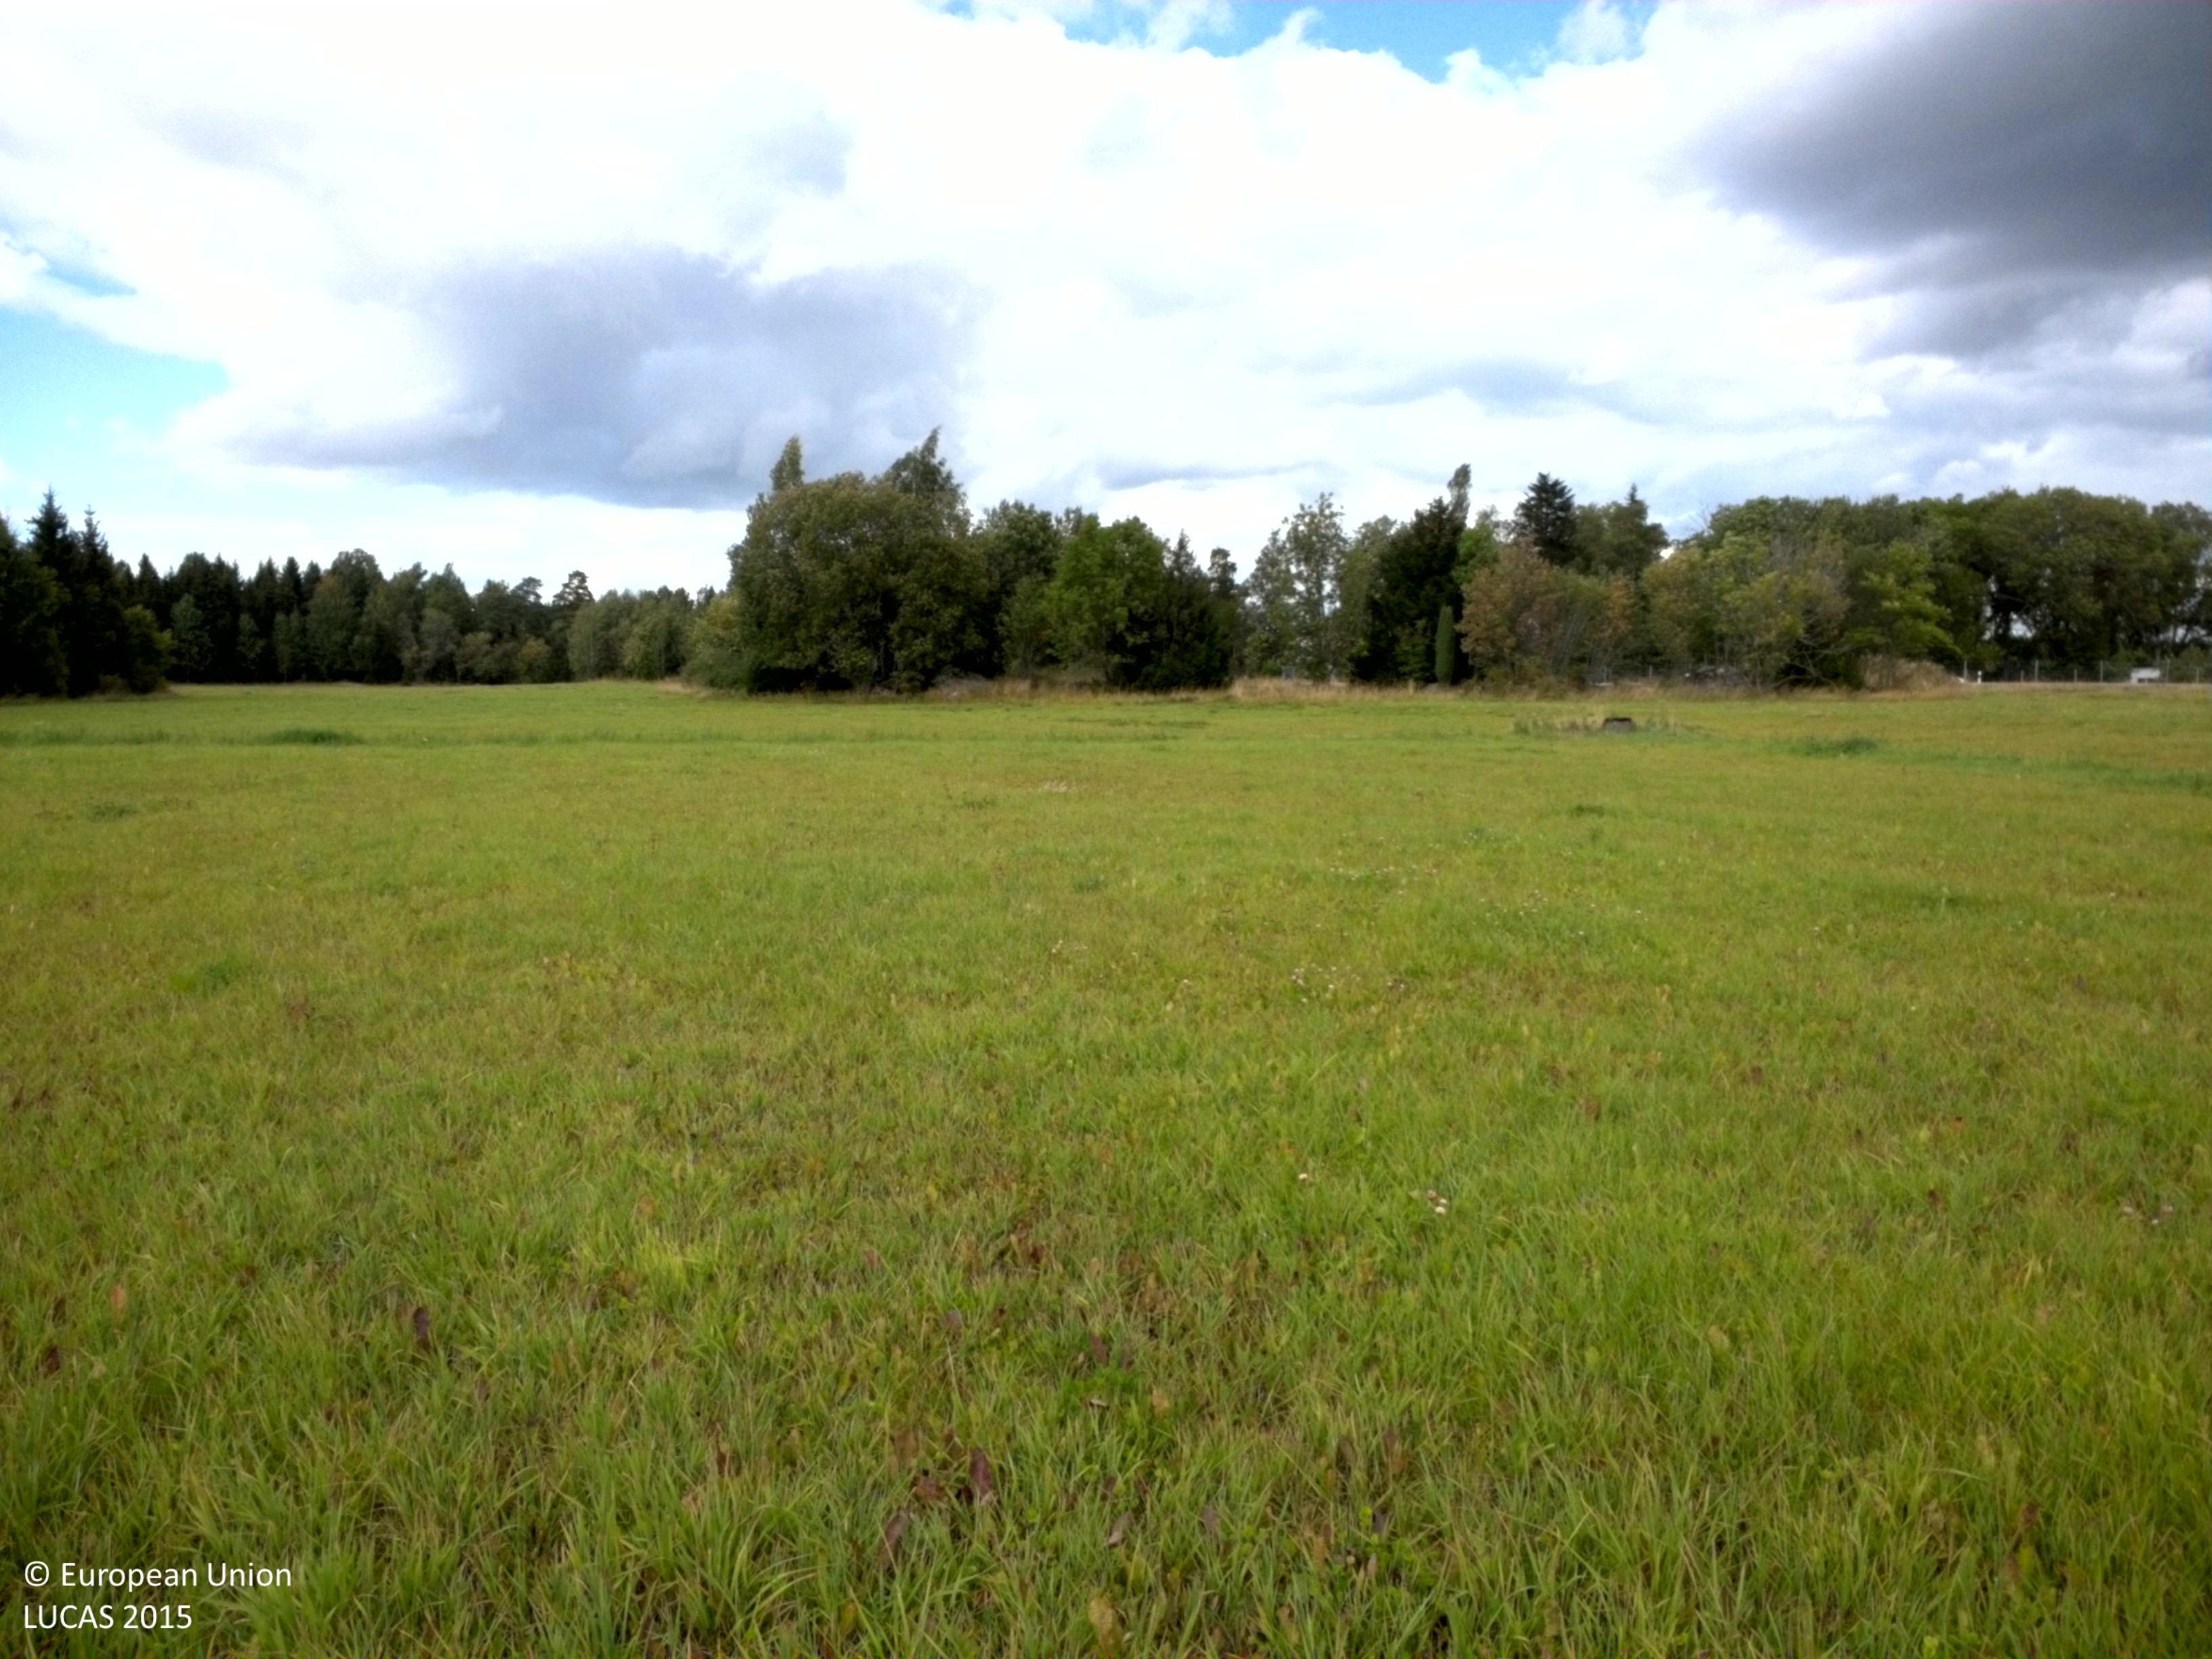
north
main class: Grassland
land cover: Grassland without tree/shrub cover
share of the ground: > 75 %
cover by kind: herbaceous plants 100 %
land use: Agriculture (excluding fallow land and kitchen gardens)
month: August
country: SE
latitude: 59.6596
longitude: 17.0748
